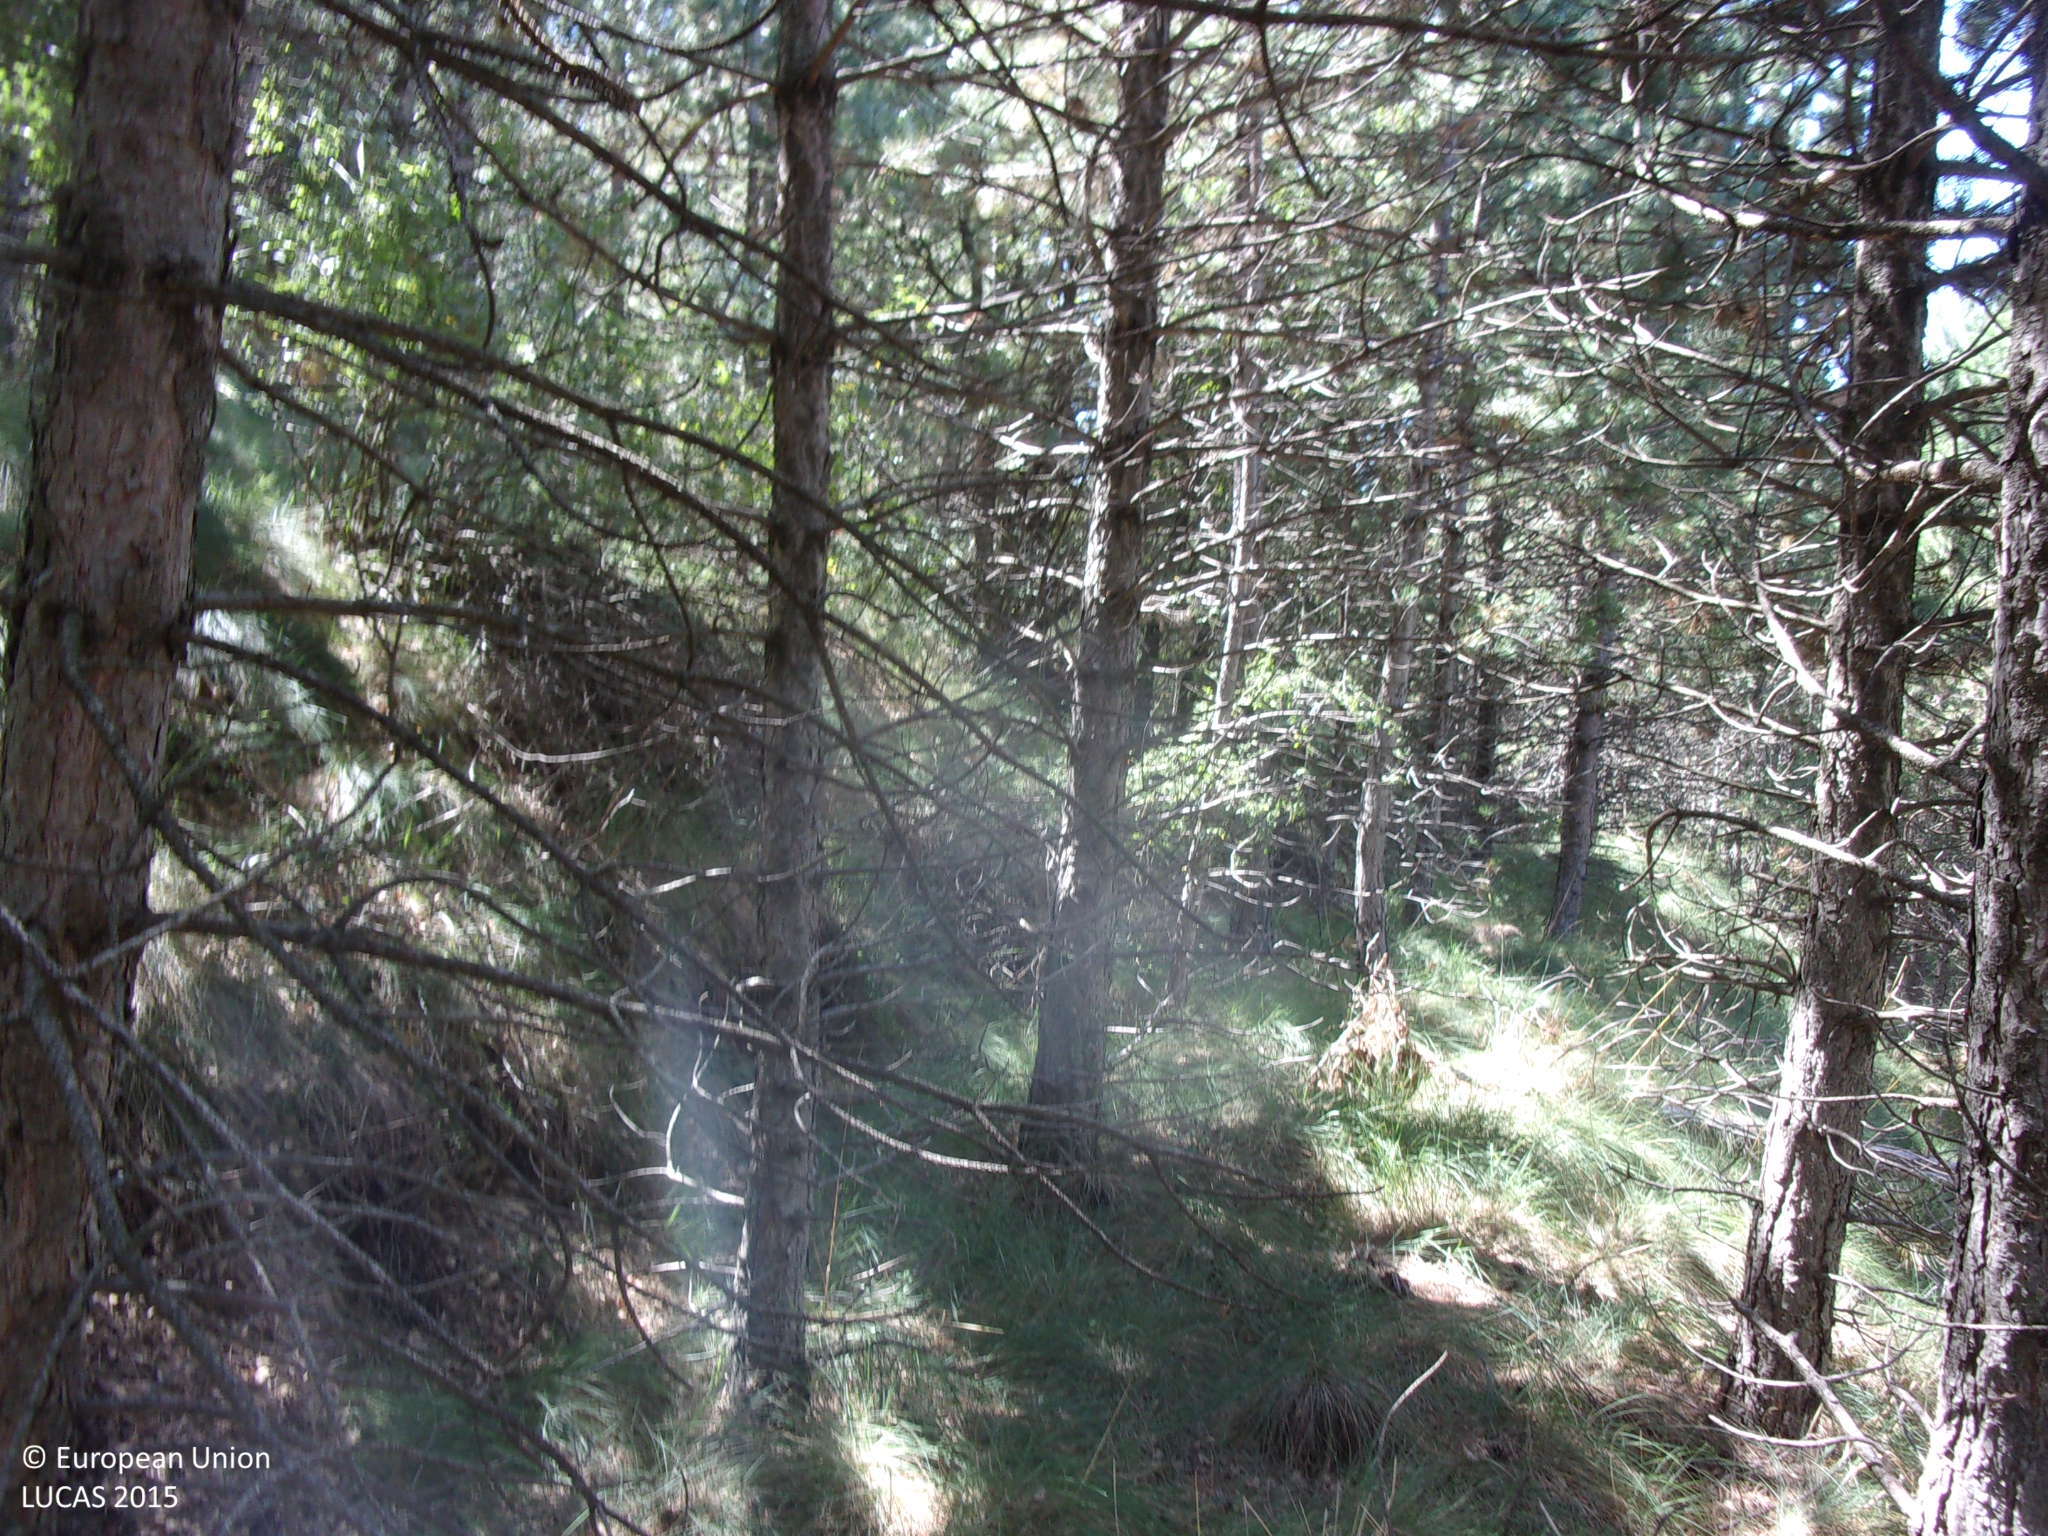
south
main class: Woodland
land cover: Pine dominated coniferous woodland
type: coniferous forest of the mediterranean region
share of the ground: > 75 %
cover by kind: coniferous forest trees 100 %
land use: Forestry
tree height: > 5 m
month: August
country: ES
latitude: 42.4518
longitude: -1.1814
